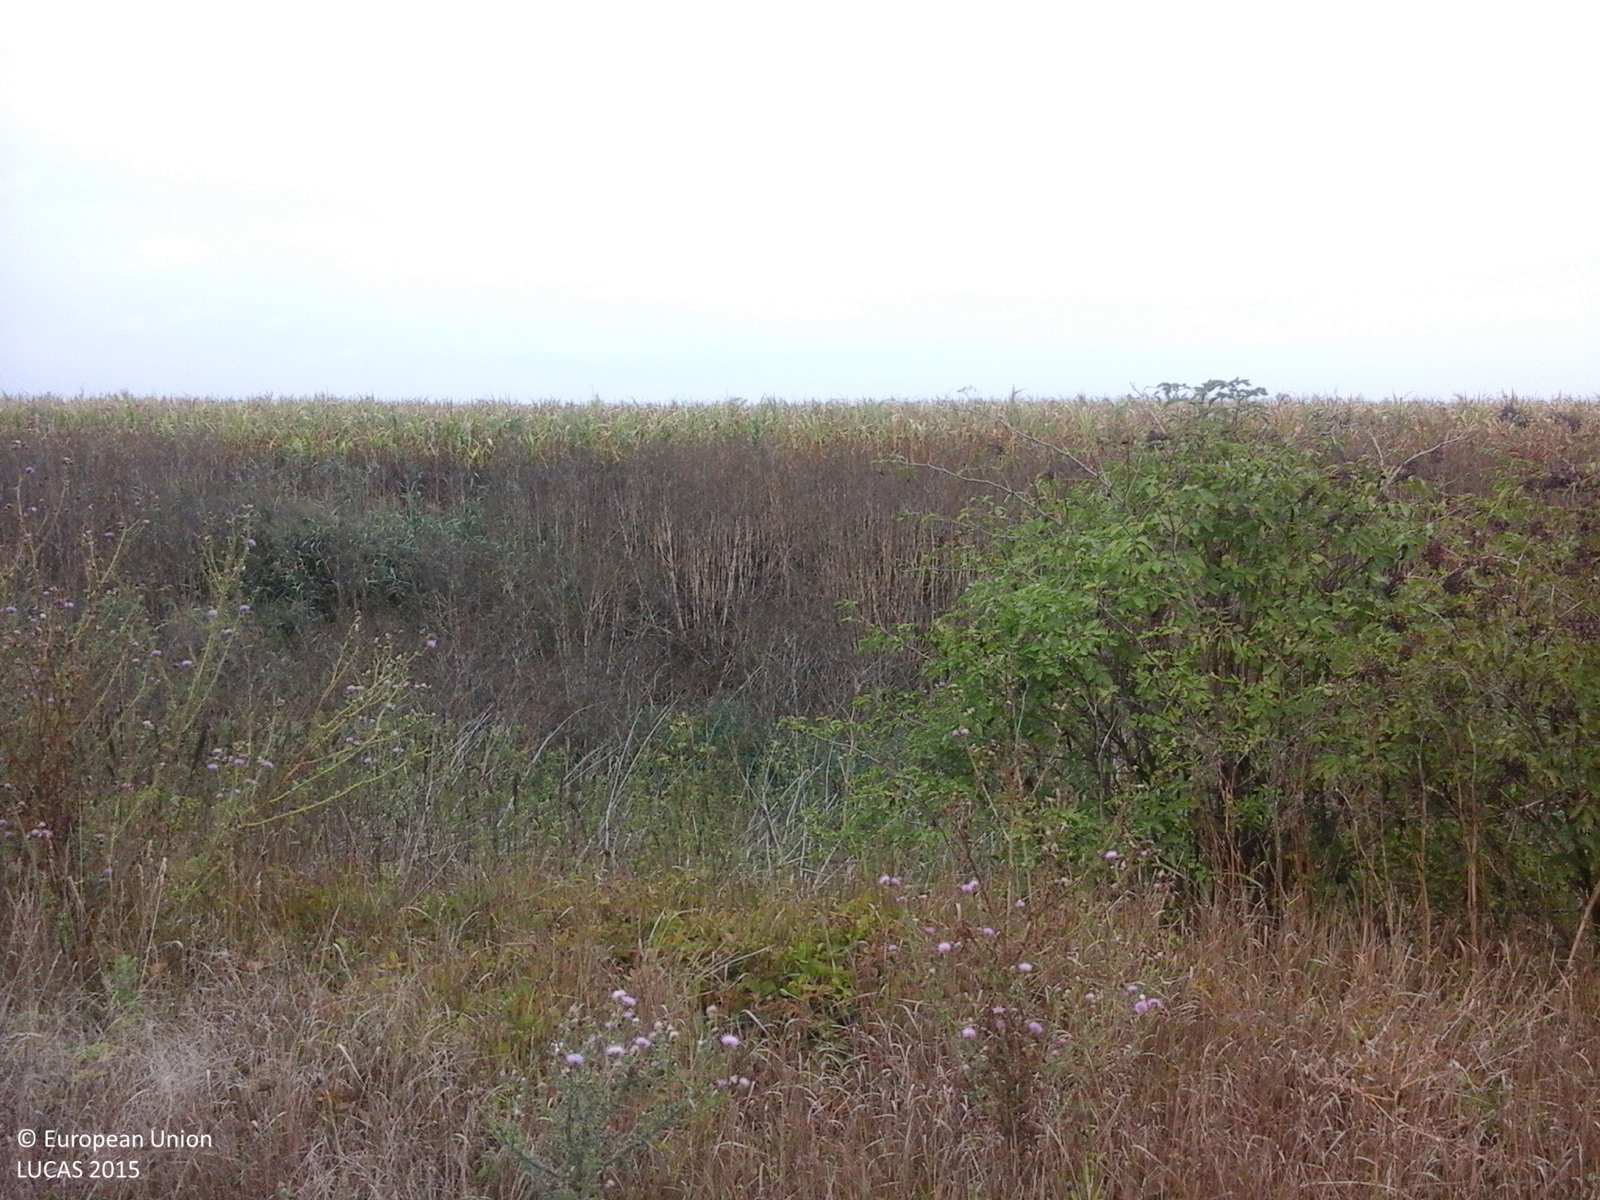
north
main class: Cropland
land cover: Maize
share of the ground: > 75 %
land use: Agriculture (excluding fallow land and kitchen gardens)
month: August
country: RO
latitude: 45.8288
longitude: 20.7228
